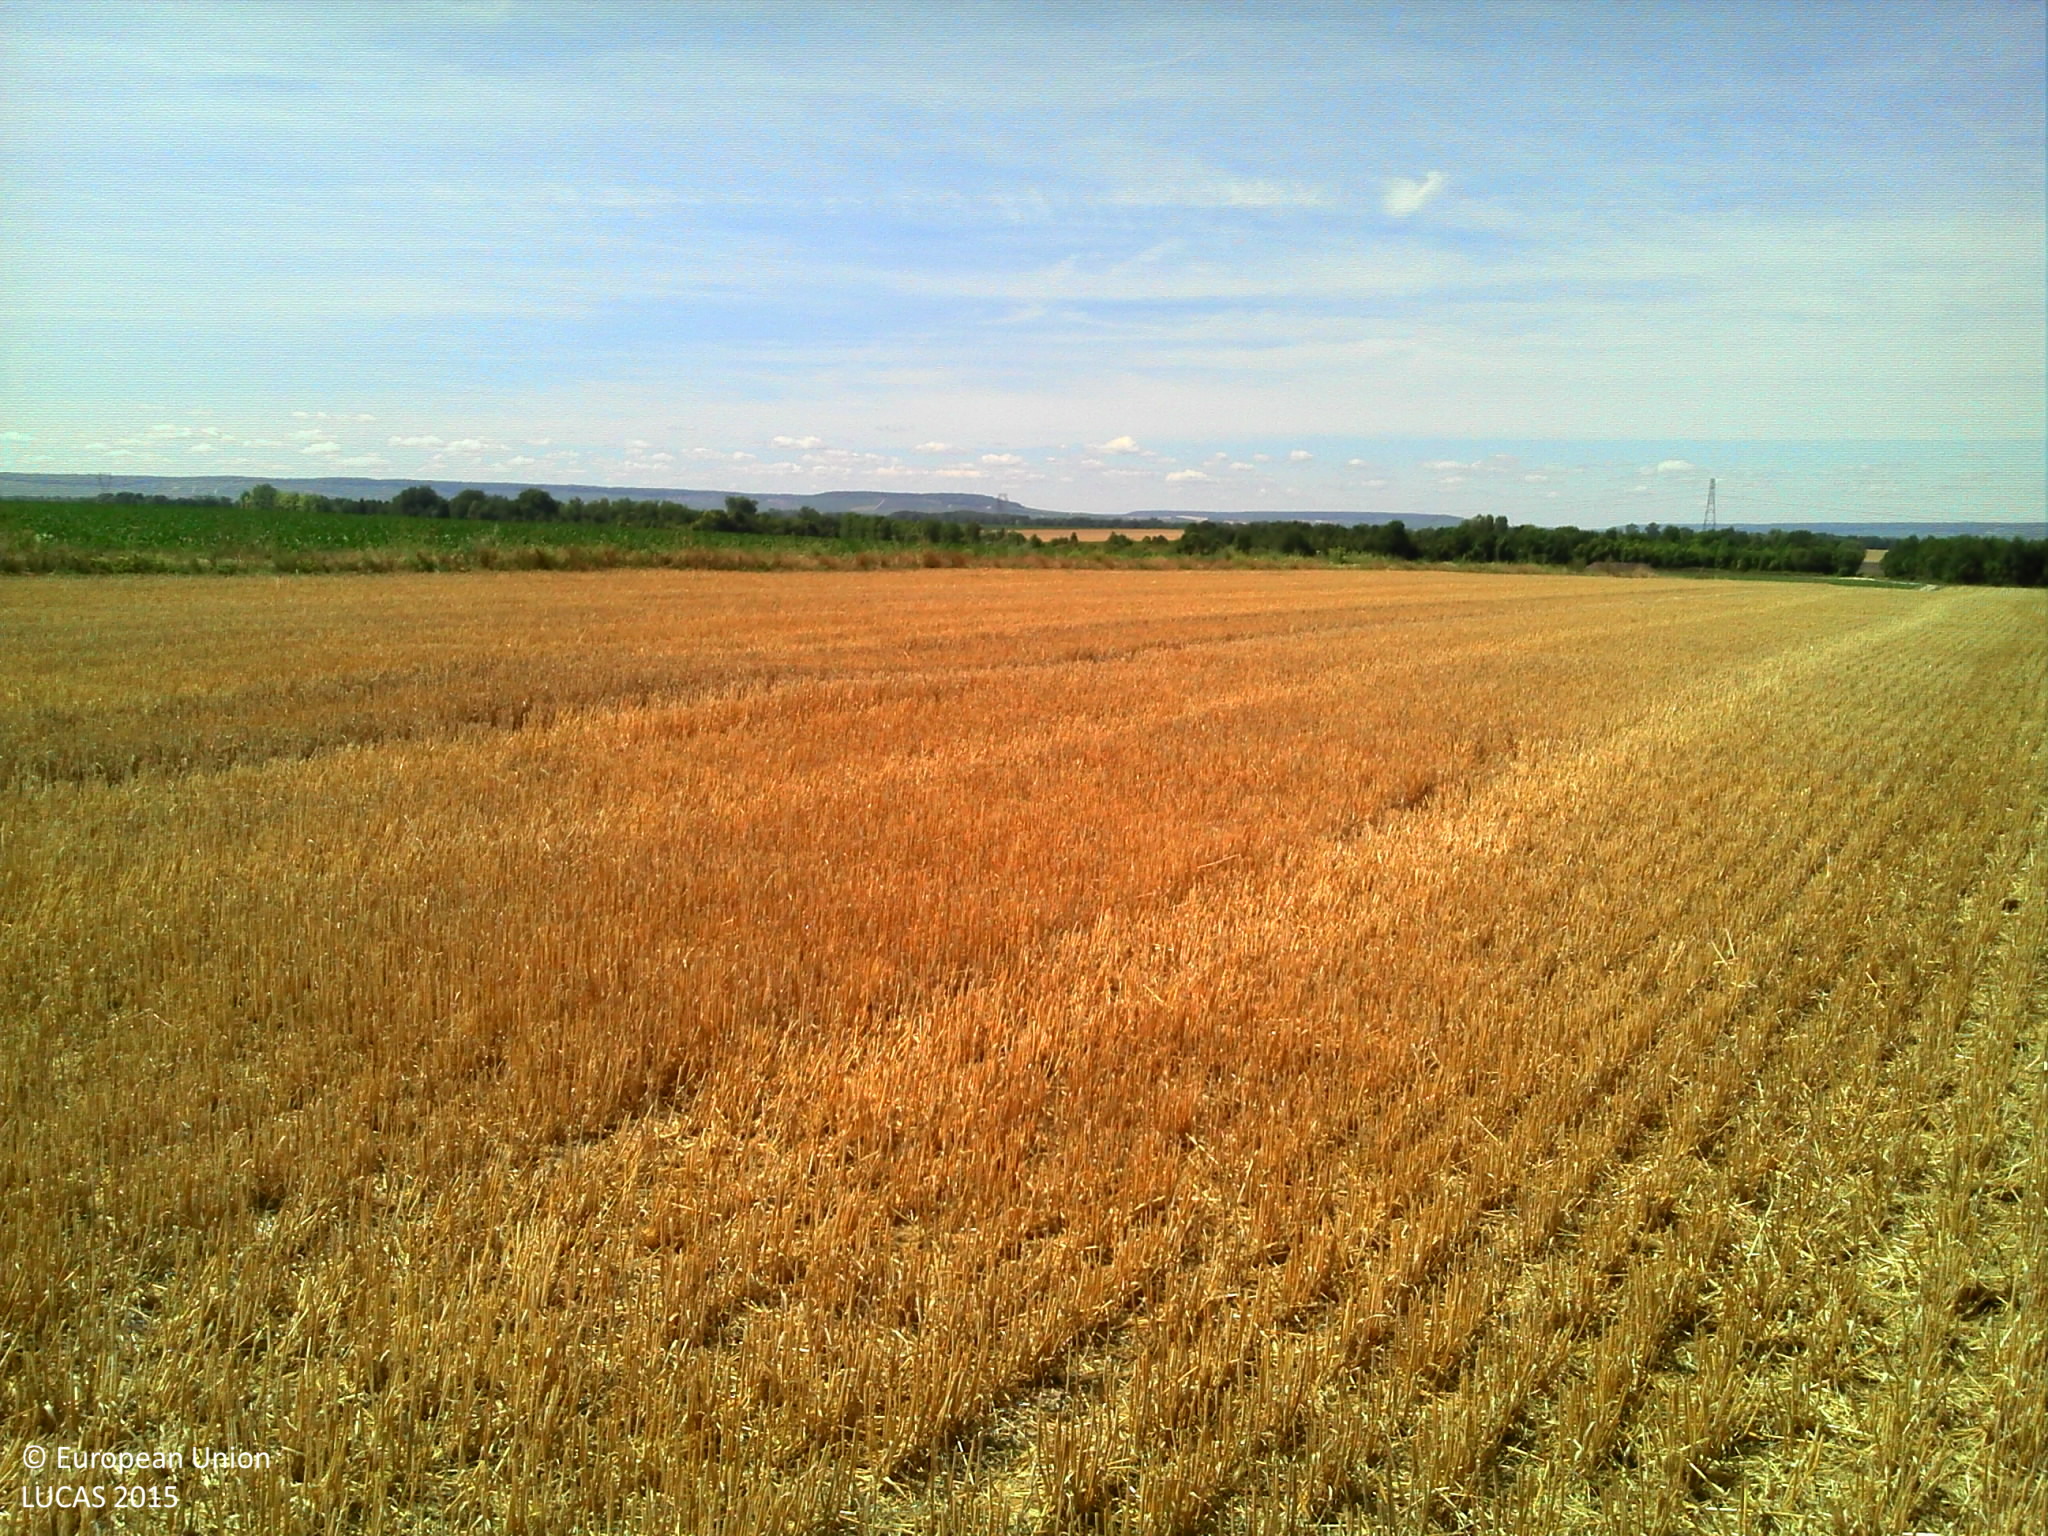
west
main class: Cropland
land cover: Barley
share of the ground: > 75 %
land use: Agriculture (excluding fallow land and kitchen gardens)
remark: Harvested field
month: August
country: FR
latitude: 48.9887
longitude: 4.1604
